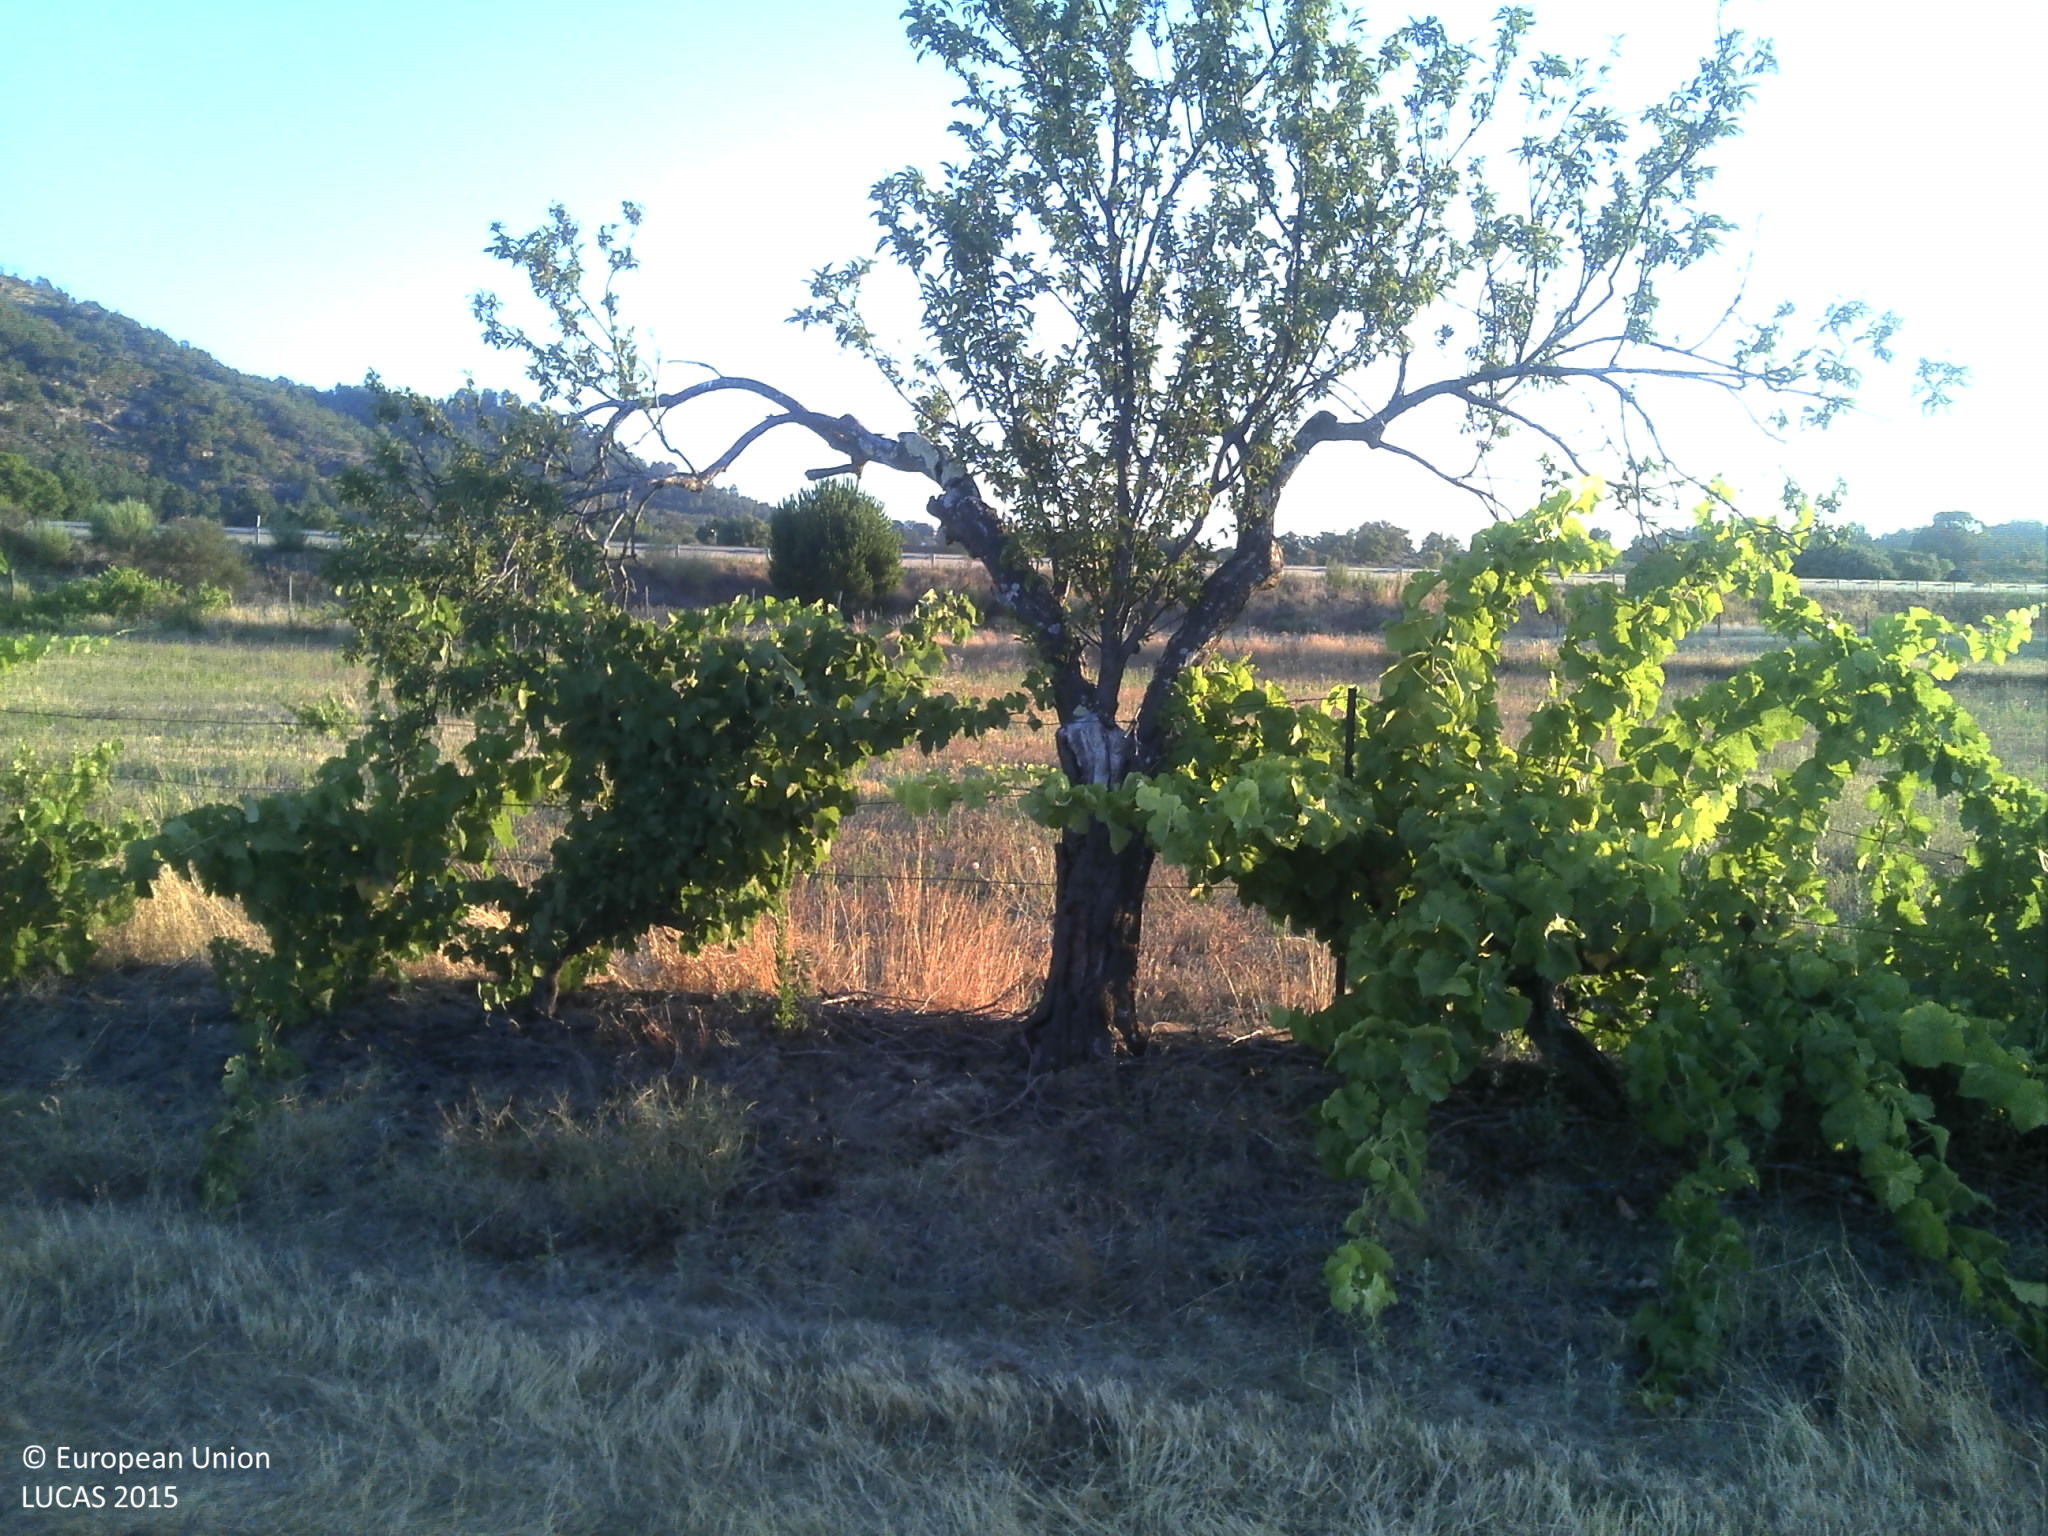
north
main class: Grassland
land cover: Grassland without tree/shrub cover
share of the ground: 50 - 75 %
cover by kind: herbaceous plants 55 %, unconsolidated bare surface 45 %
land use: Agriculture (excluding fallow land and kitchen gardens)
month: July
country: PT
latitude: 40.3322
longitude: -7.3481
